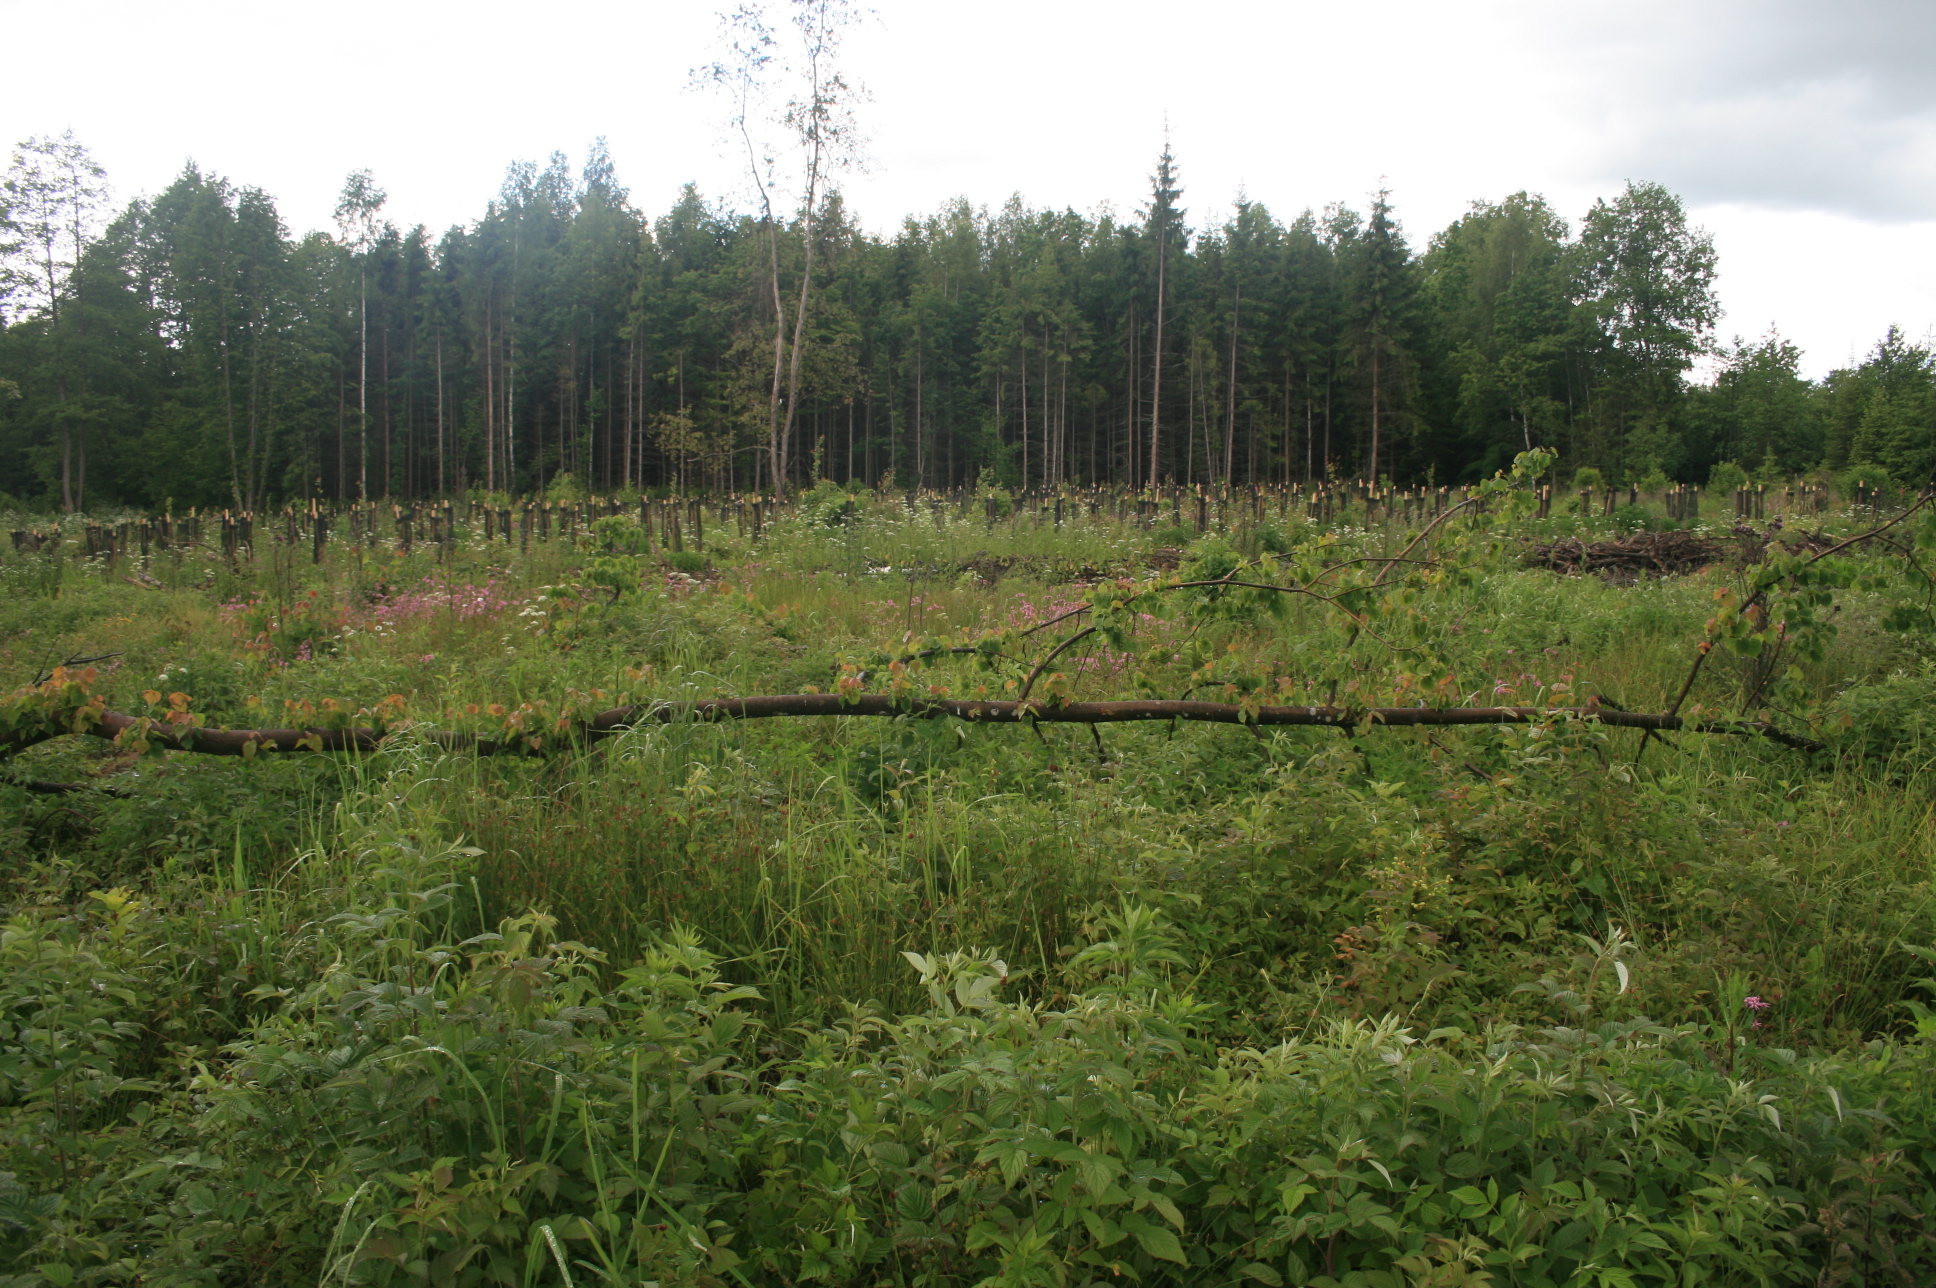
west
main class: Shrubland
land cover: Shrubland with sparse tree cover
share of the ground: > 75 %
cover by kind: shrubs 65 %, herbaceous plants 30 %, broadleaved forest trees 5 %
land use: Forestry
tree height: < 5 m
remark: Clear cut
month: June
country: LT
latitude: 55.3440
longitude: 22.0541
